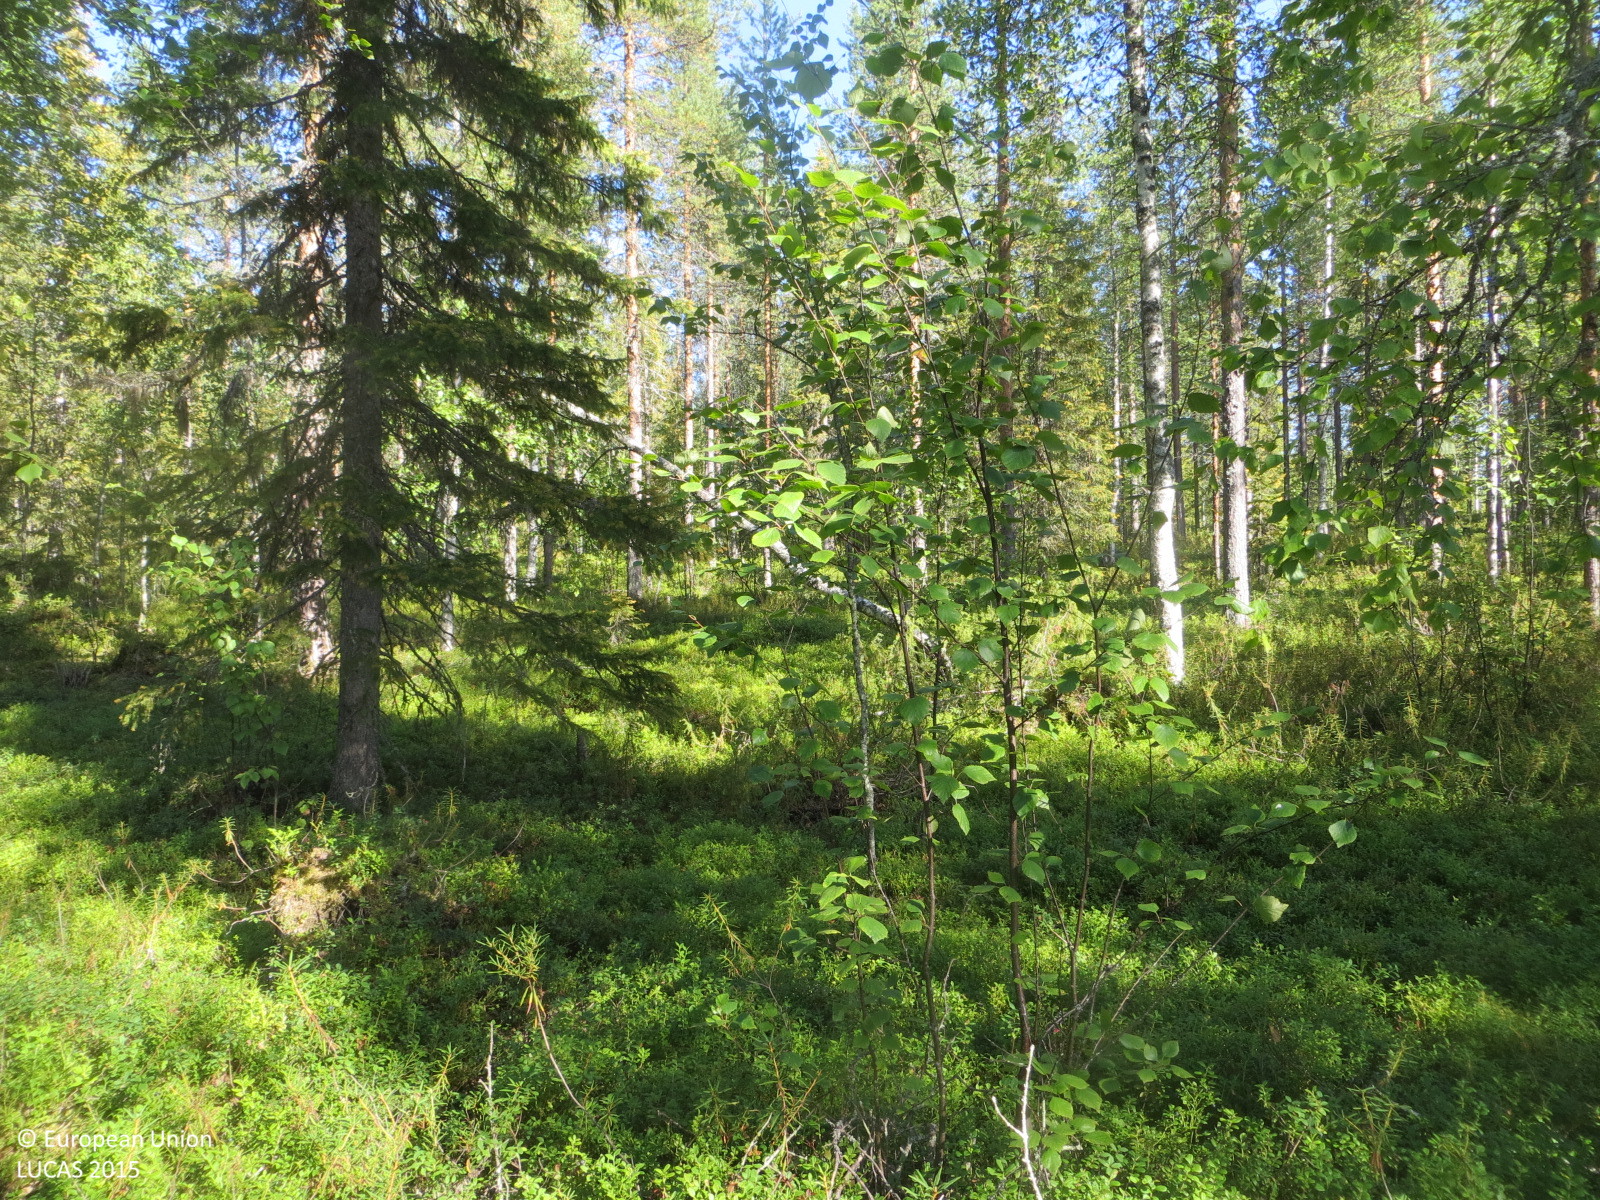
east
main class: Woodland
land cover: Other mixed woodland
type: boreal forest
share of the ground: 25 - 50 %
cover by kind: shrubs 55 %, coniferous forest trees 25 %, broadleaved forest trees 20 %
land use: Forestry
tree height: > 5 m
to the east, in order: Other mixed woodland; Tracks; Pine dominated mixed woodland; Tracks; Pine dominated mixed woodland; Pine dominated coniferous woodland
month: August
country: FI
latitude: 66.8508
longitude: 24.8863
